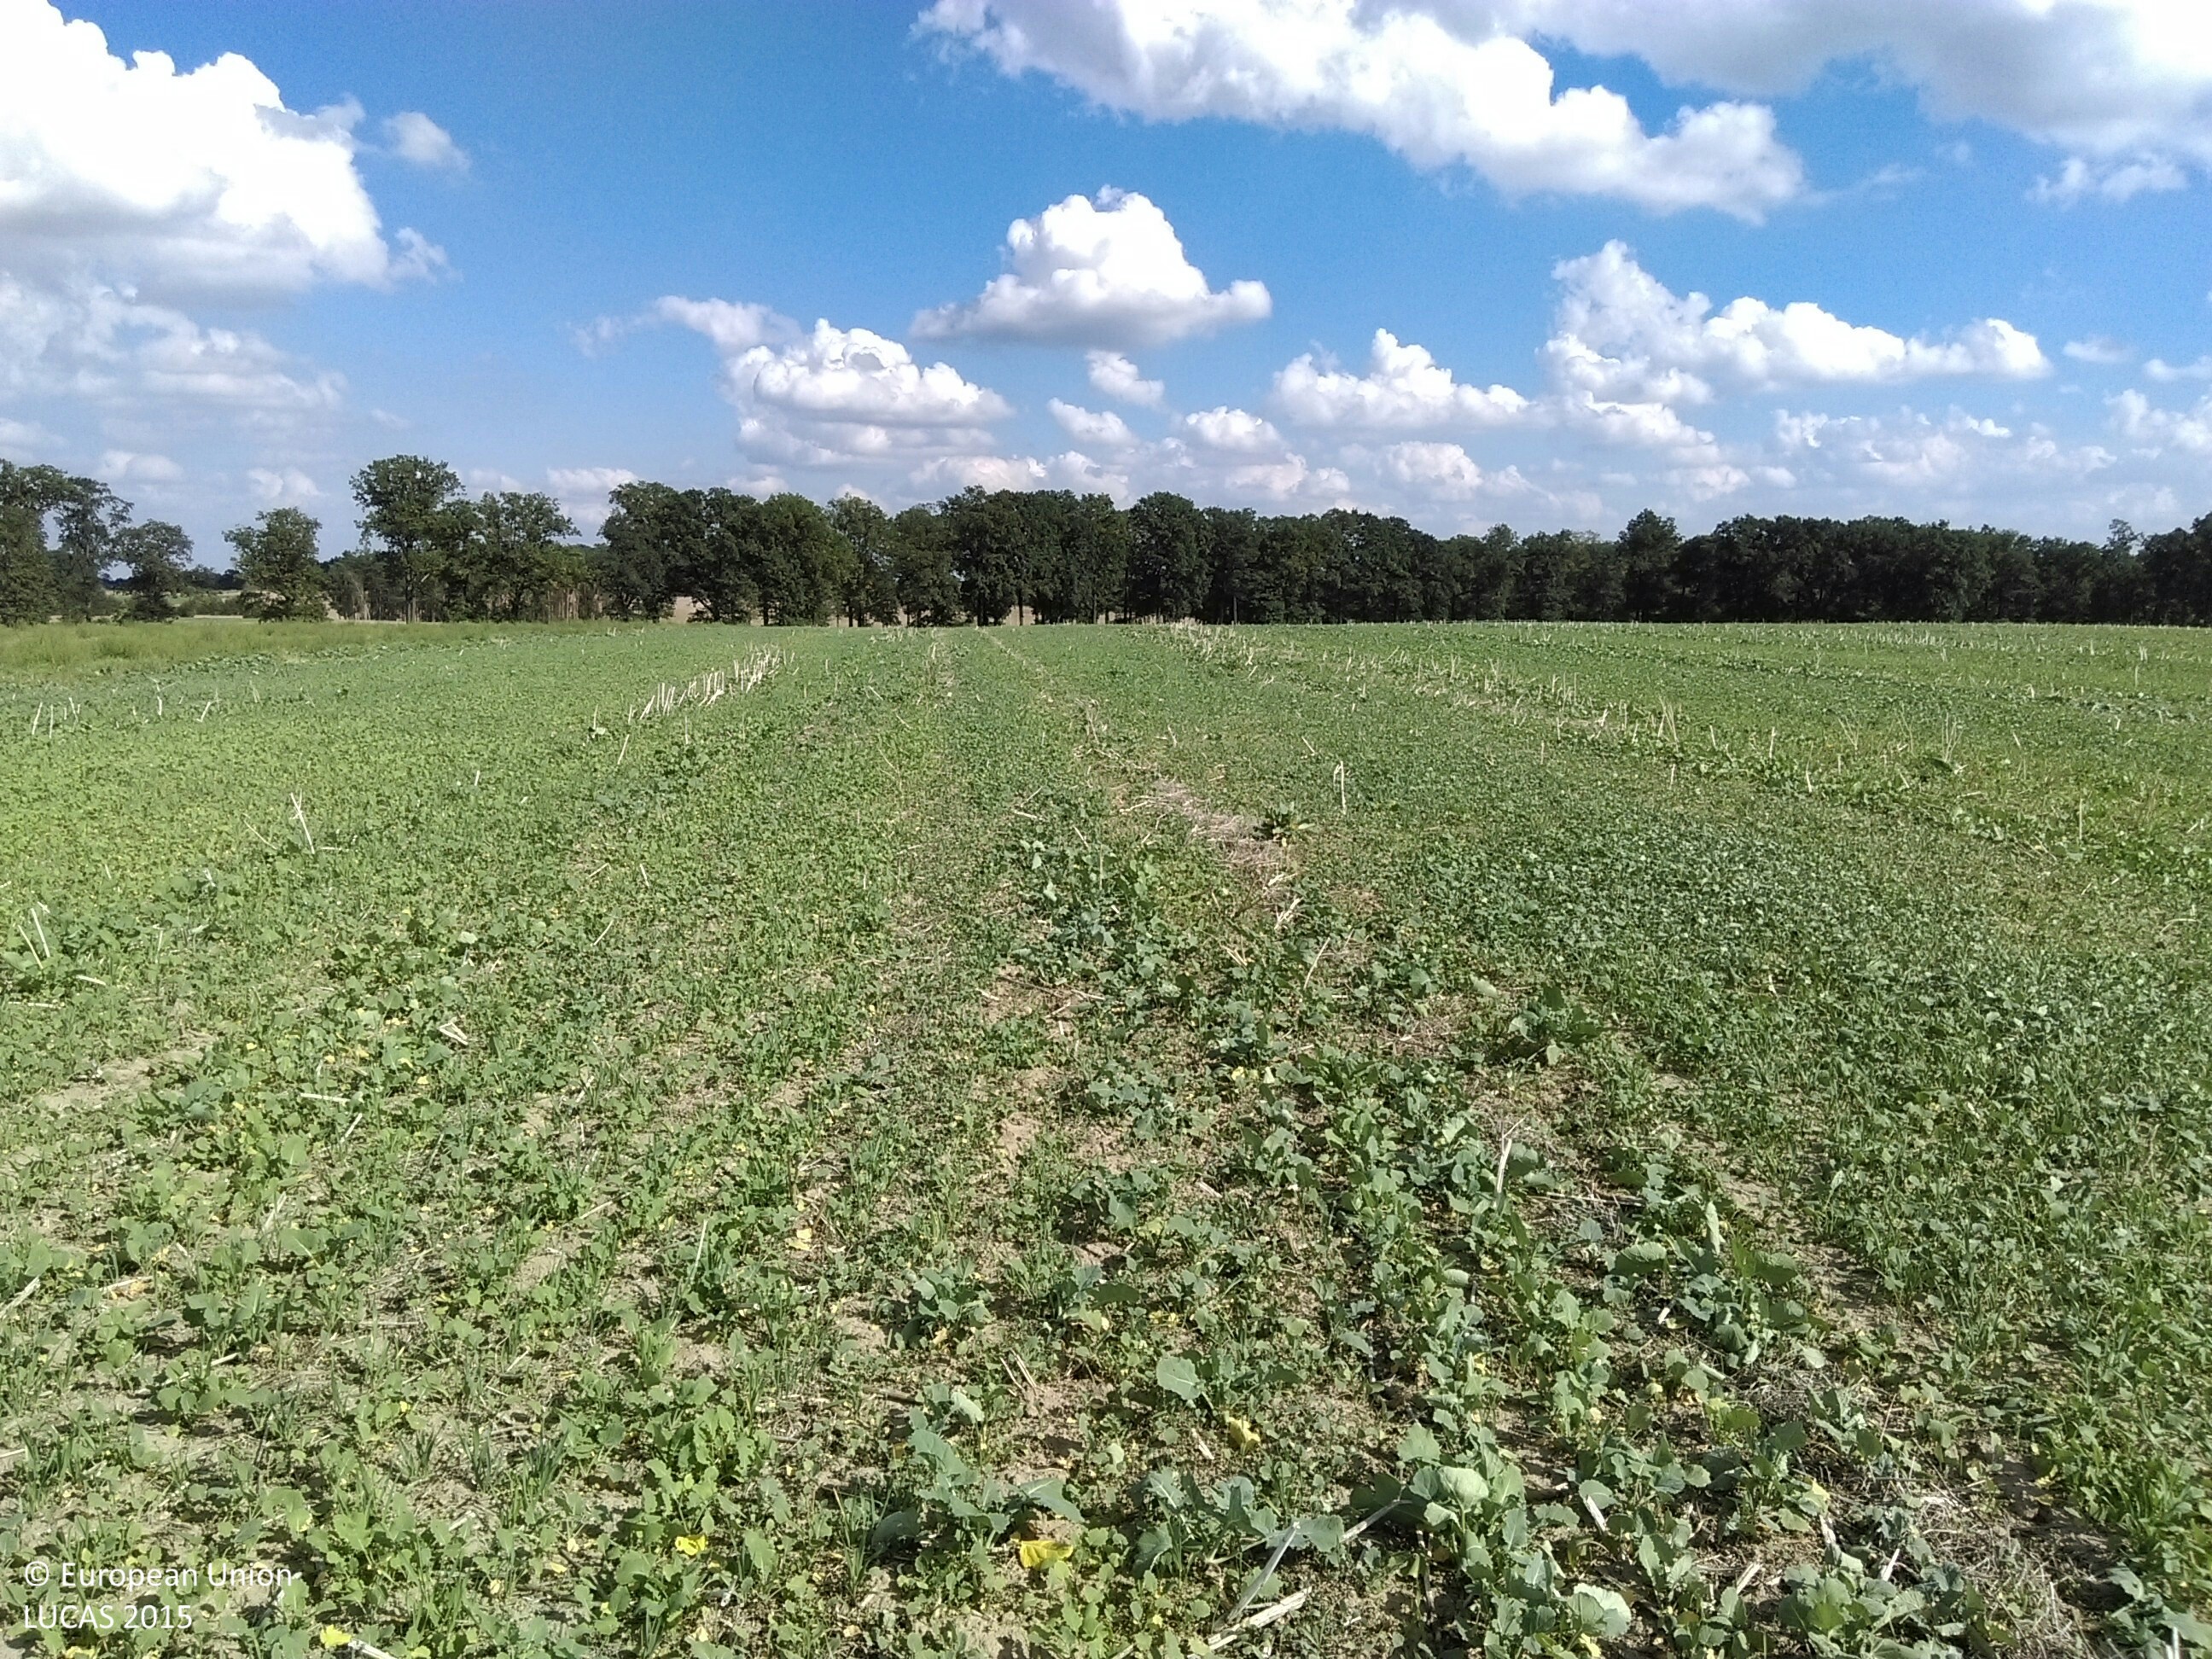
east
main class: Cropland
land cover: Rape and turnip rape
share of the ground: > 75 %
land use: Agriculture (excluding fallow land and kitchen gardens)
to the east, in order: Rape and turnip rape
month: September
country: PL
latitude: 52.0872
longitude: 16.2383
